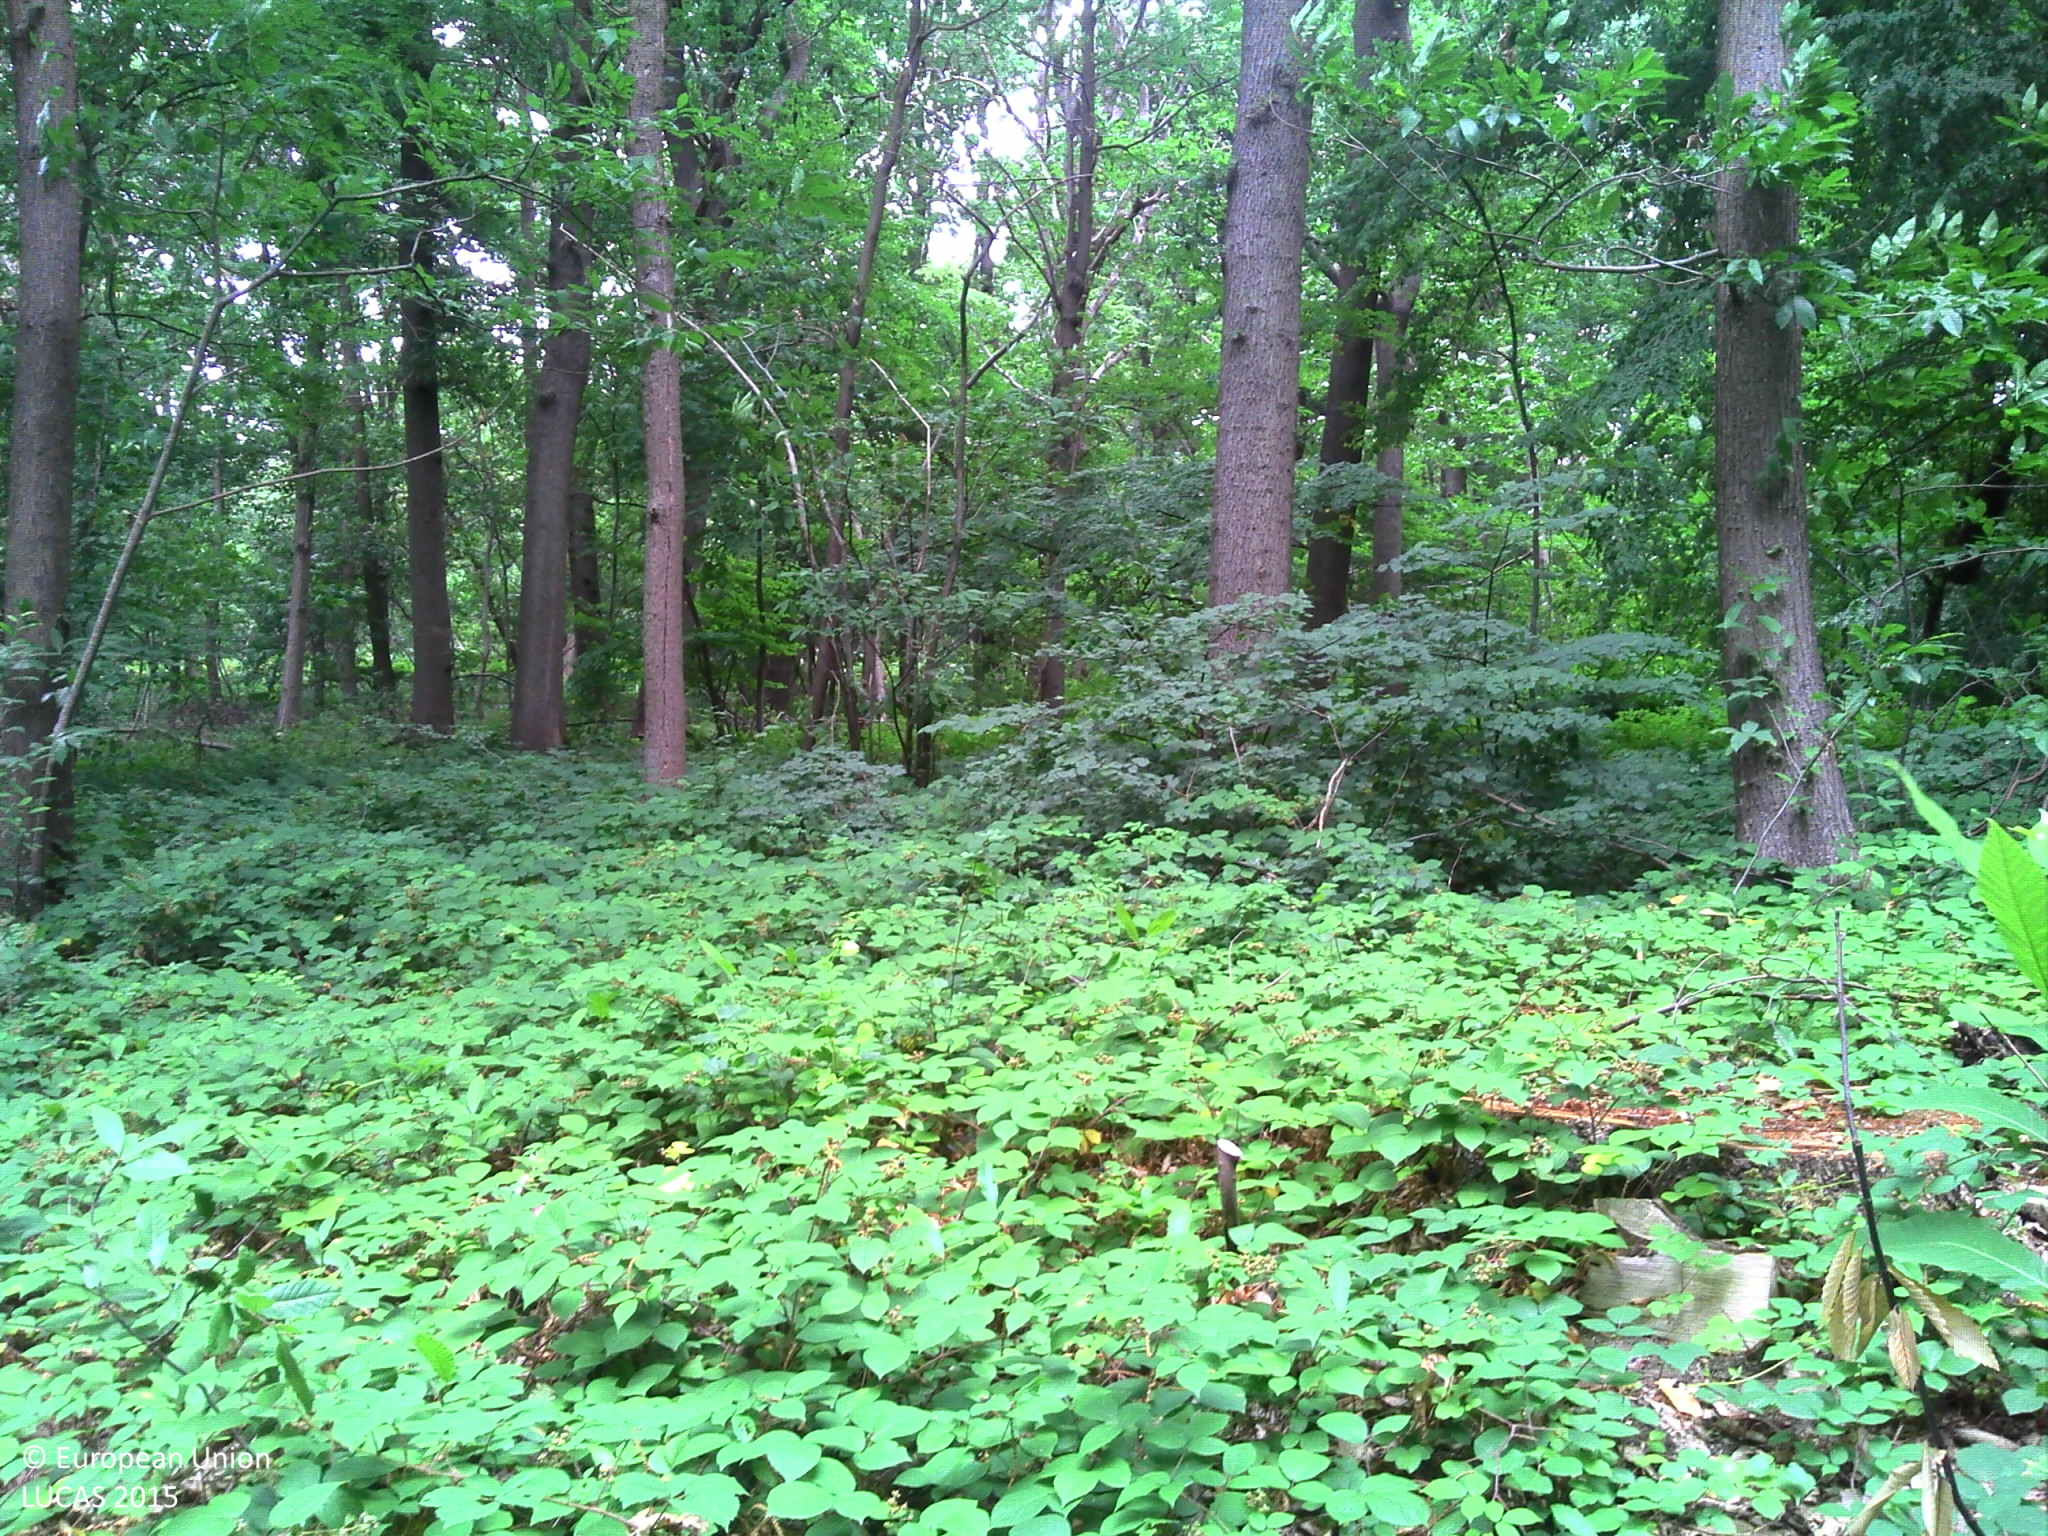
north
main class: Woodland
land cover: Broadleaved woodland
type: mesophytic deciduous forest
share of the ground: > 75 %
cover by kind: broadleaved forest trees 40 %, shrubs 20 %, lichens and mosses 10 %, consolidated bare surface 5 %
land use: Forestry
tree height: > 5 m
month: July
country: FR
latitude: 49.0929
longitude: 2.3048
